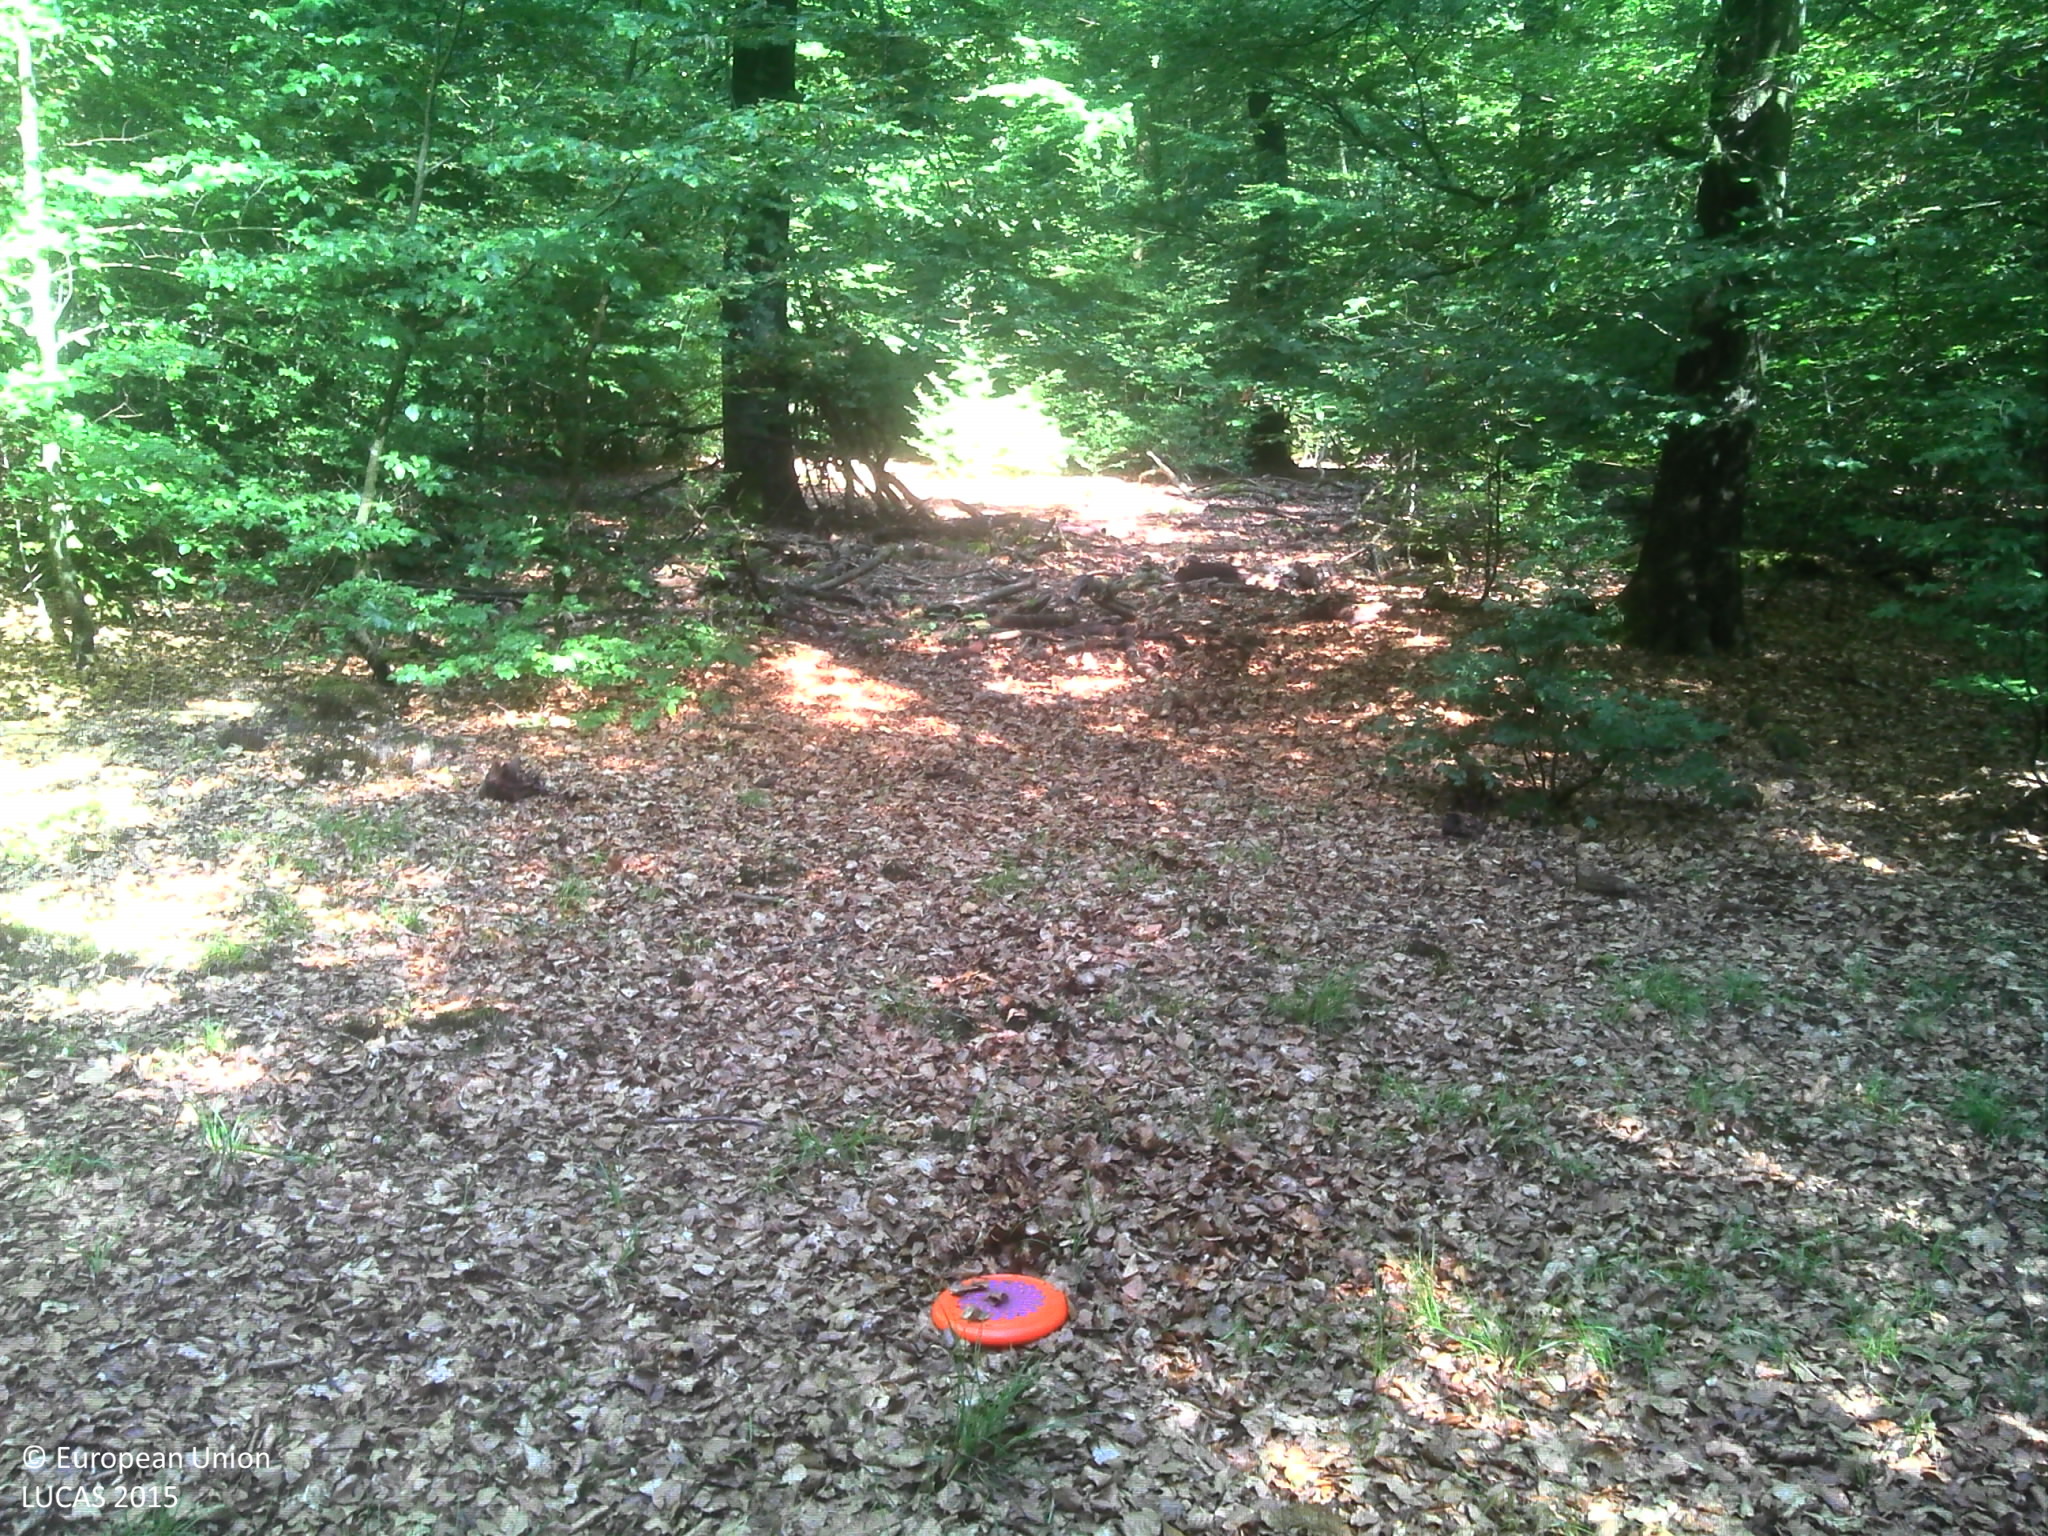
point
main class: Woodland
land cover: Broadleaved woodland
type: beech forest
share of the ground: > 75 %
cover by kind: broadleaved forest trees 80 %, shrubs 10 %, herbaceous plants 5 %, unconsolidated bare surface 5 %
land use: Forestry
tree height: > 5 m
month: July
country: BE
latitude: 49.8141
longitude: 5.6766
